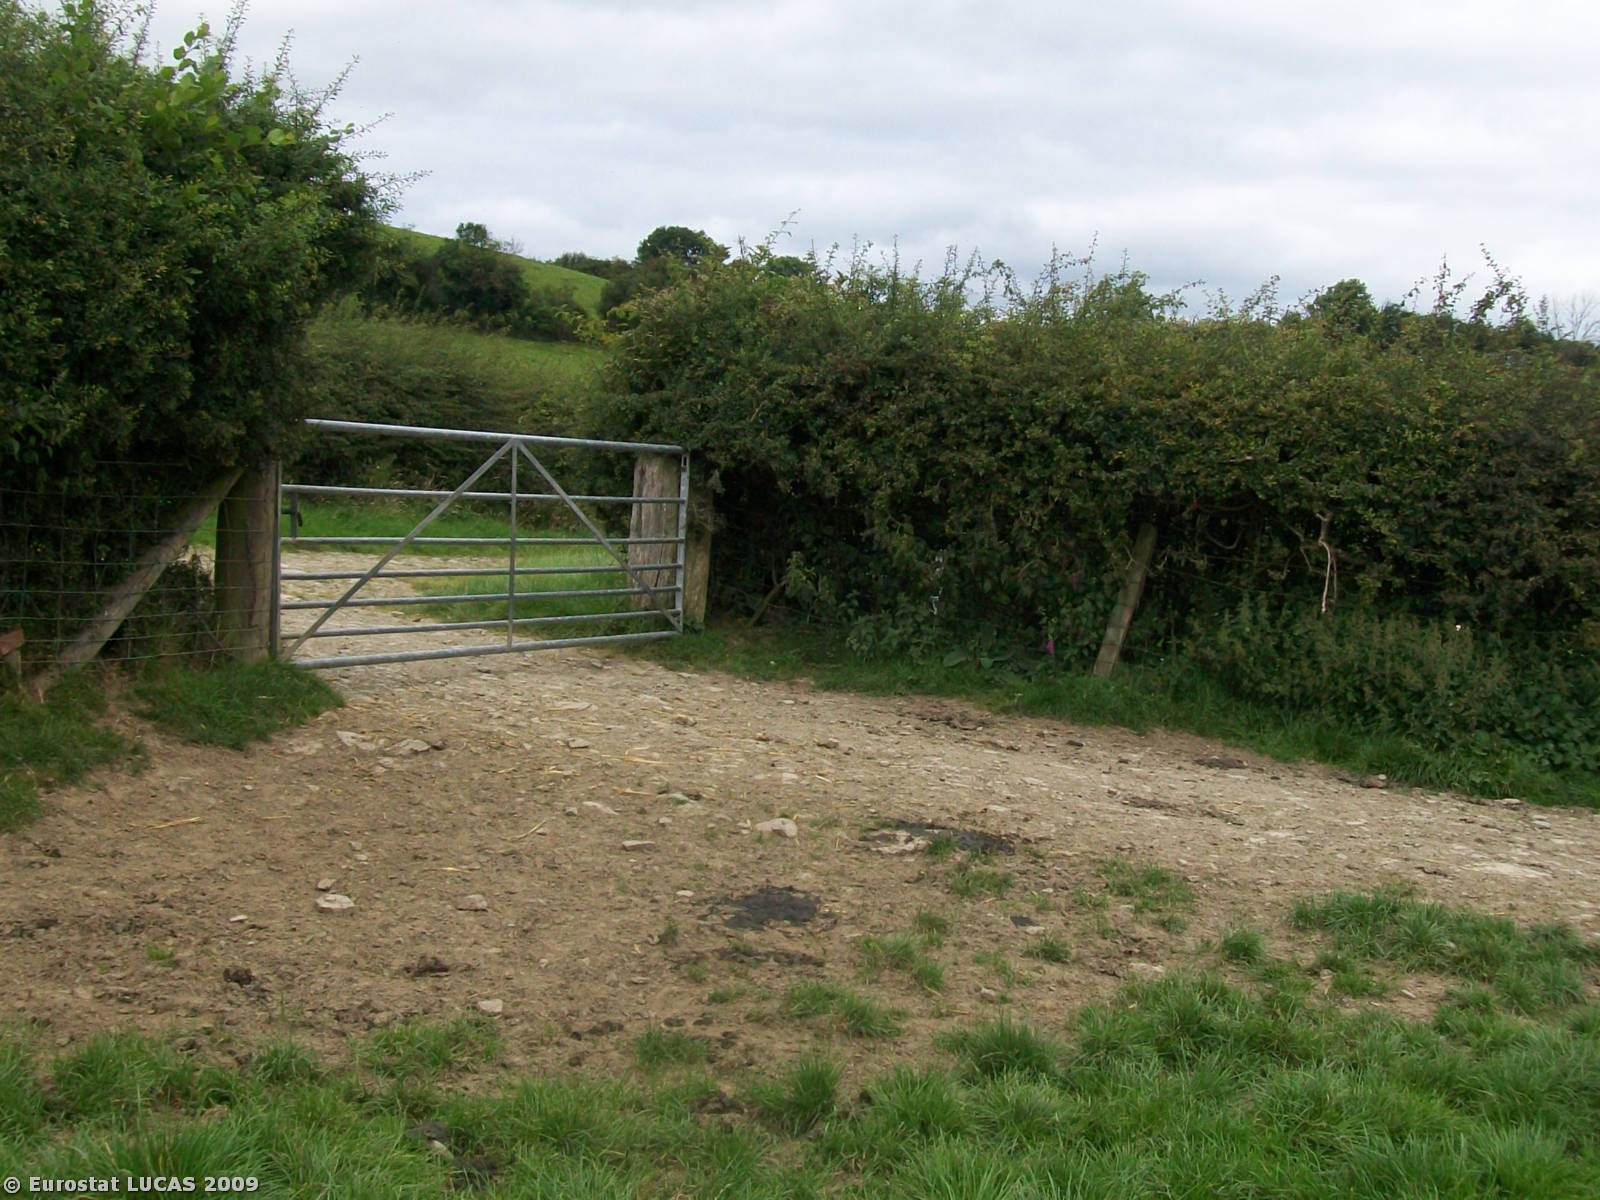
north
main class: Grassland
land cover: Grassland without tree/shrub cover
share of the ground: > 75 %
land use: Agriculture (excluding fallow land and kitchen gardens)
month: August
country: GB
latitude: 52.5344
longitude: -3.1542
